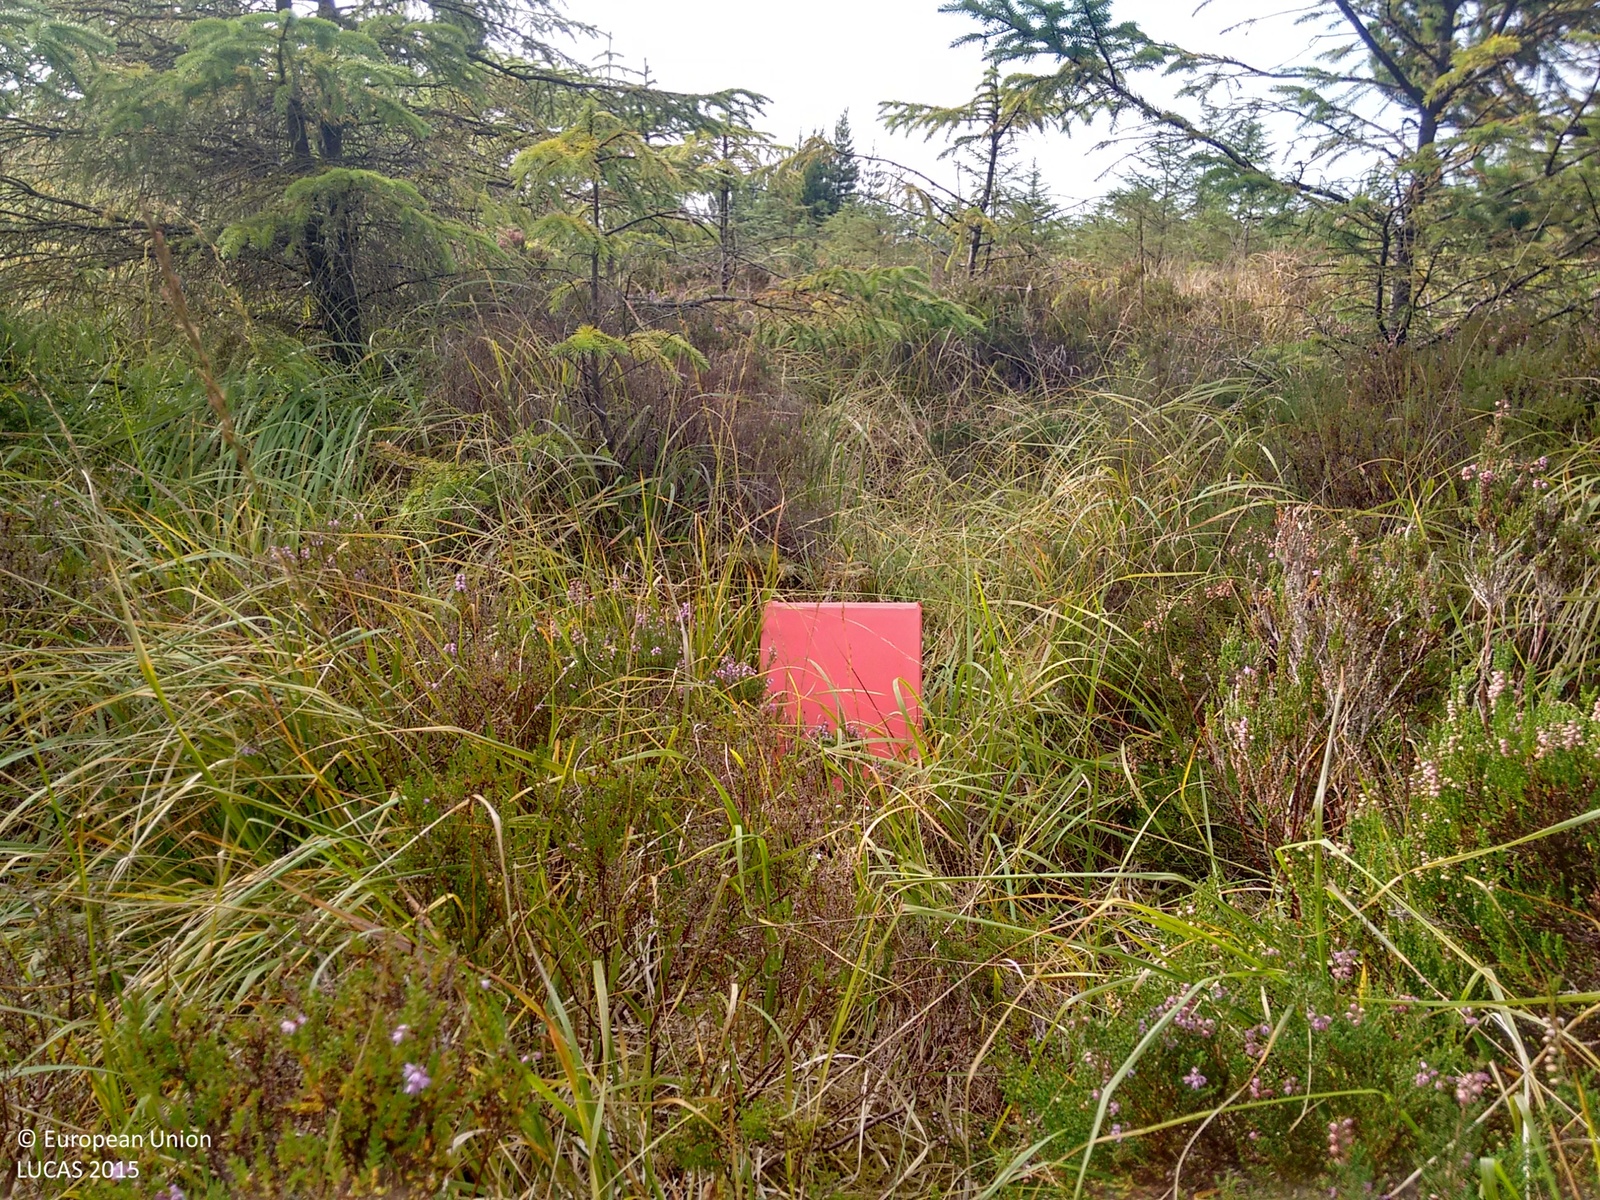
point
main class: Woodland
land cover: Pine dominated coniferous woodland
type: exotic forest
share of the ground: > 75 %
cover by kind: coniferous forest trees 80 %, herbaceous plants 15 %, shrubs 5 %
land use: Forestry
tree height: < 5 m
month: September
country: IE
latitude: 52.4434
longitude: -9.1532
